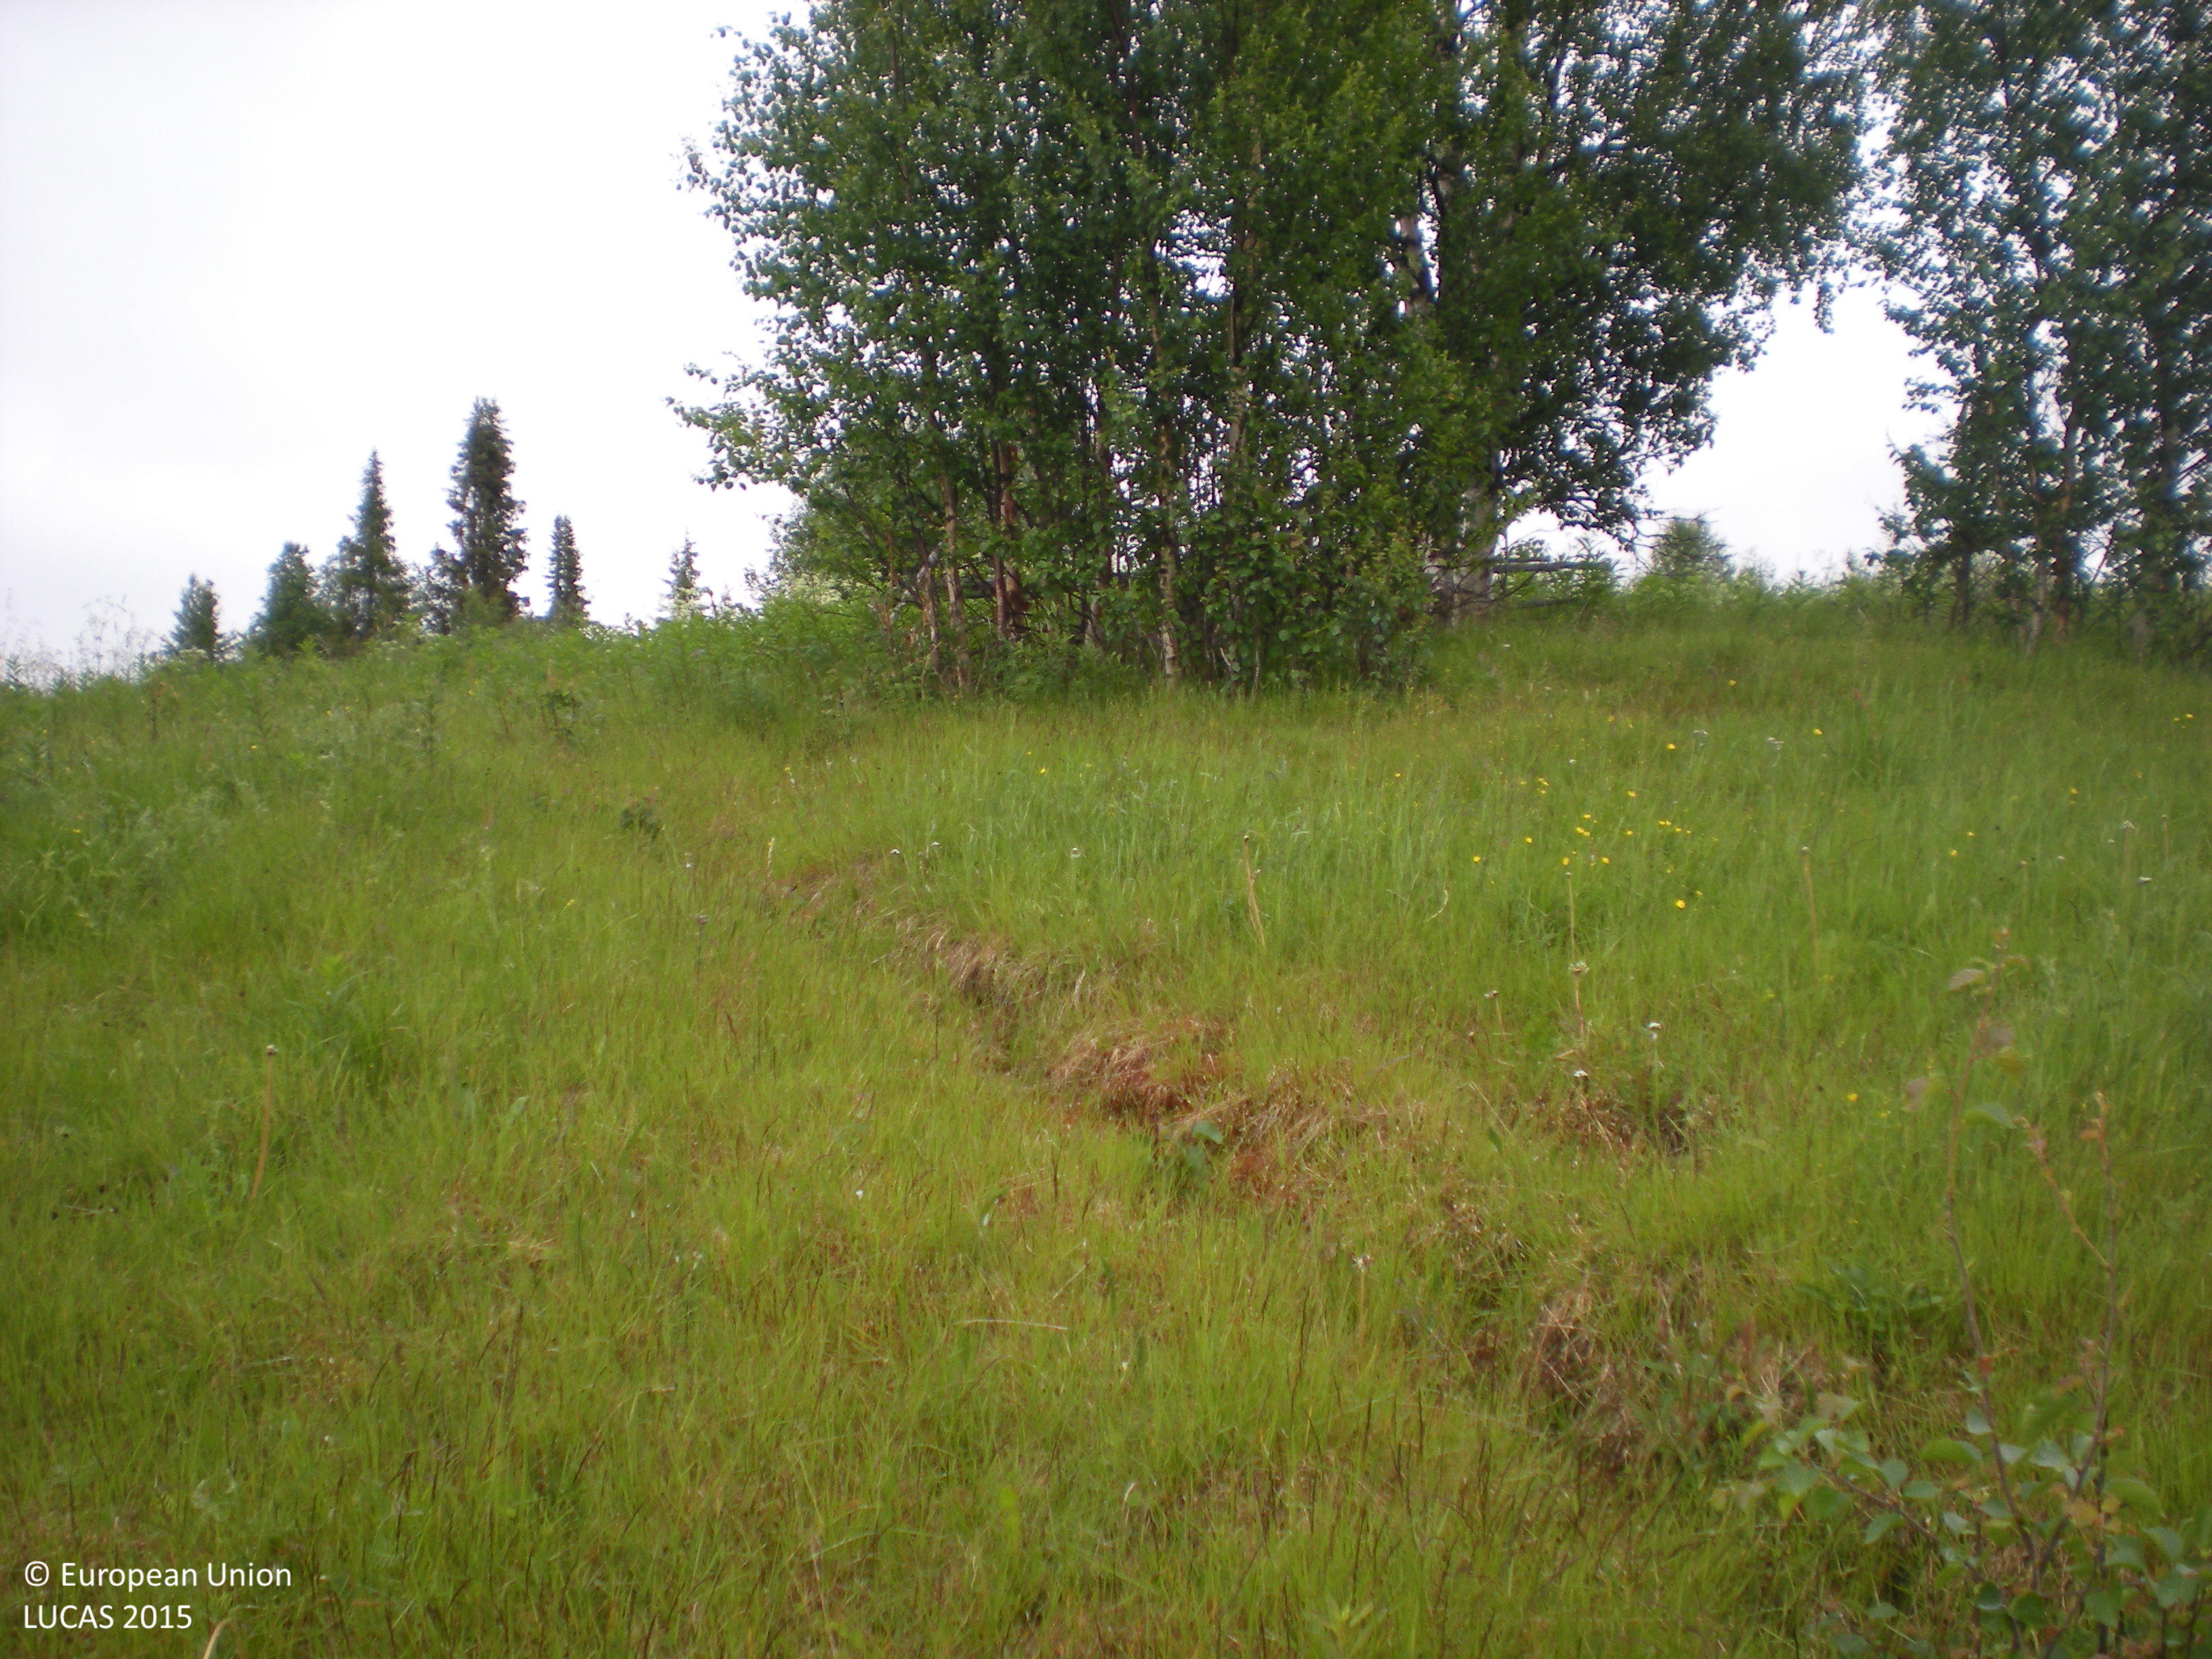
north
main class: Grassland
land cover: Grassland with sparse tree/shrub cover
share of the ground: > 75 %
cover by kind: herbaceous plants 95 %, broadleaved forest trees 5 %
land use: Agriculture (excluding fallow land and kitchen gardens)
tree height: < 5 m
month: July
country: SE
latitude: 65.8143
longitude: 17.1982
